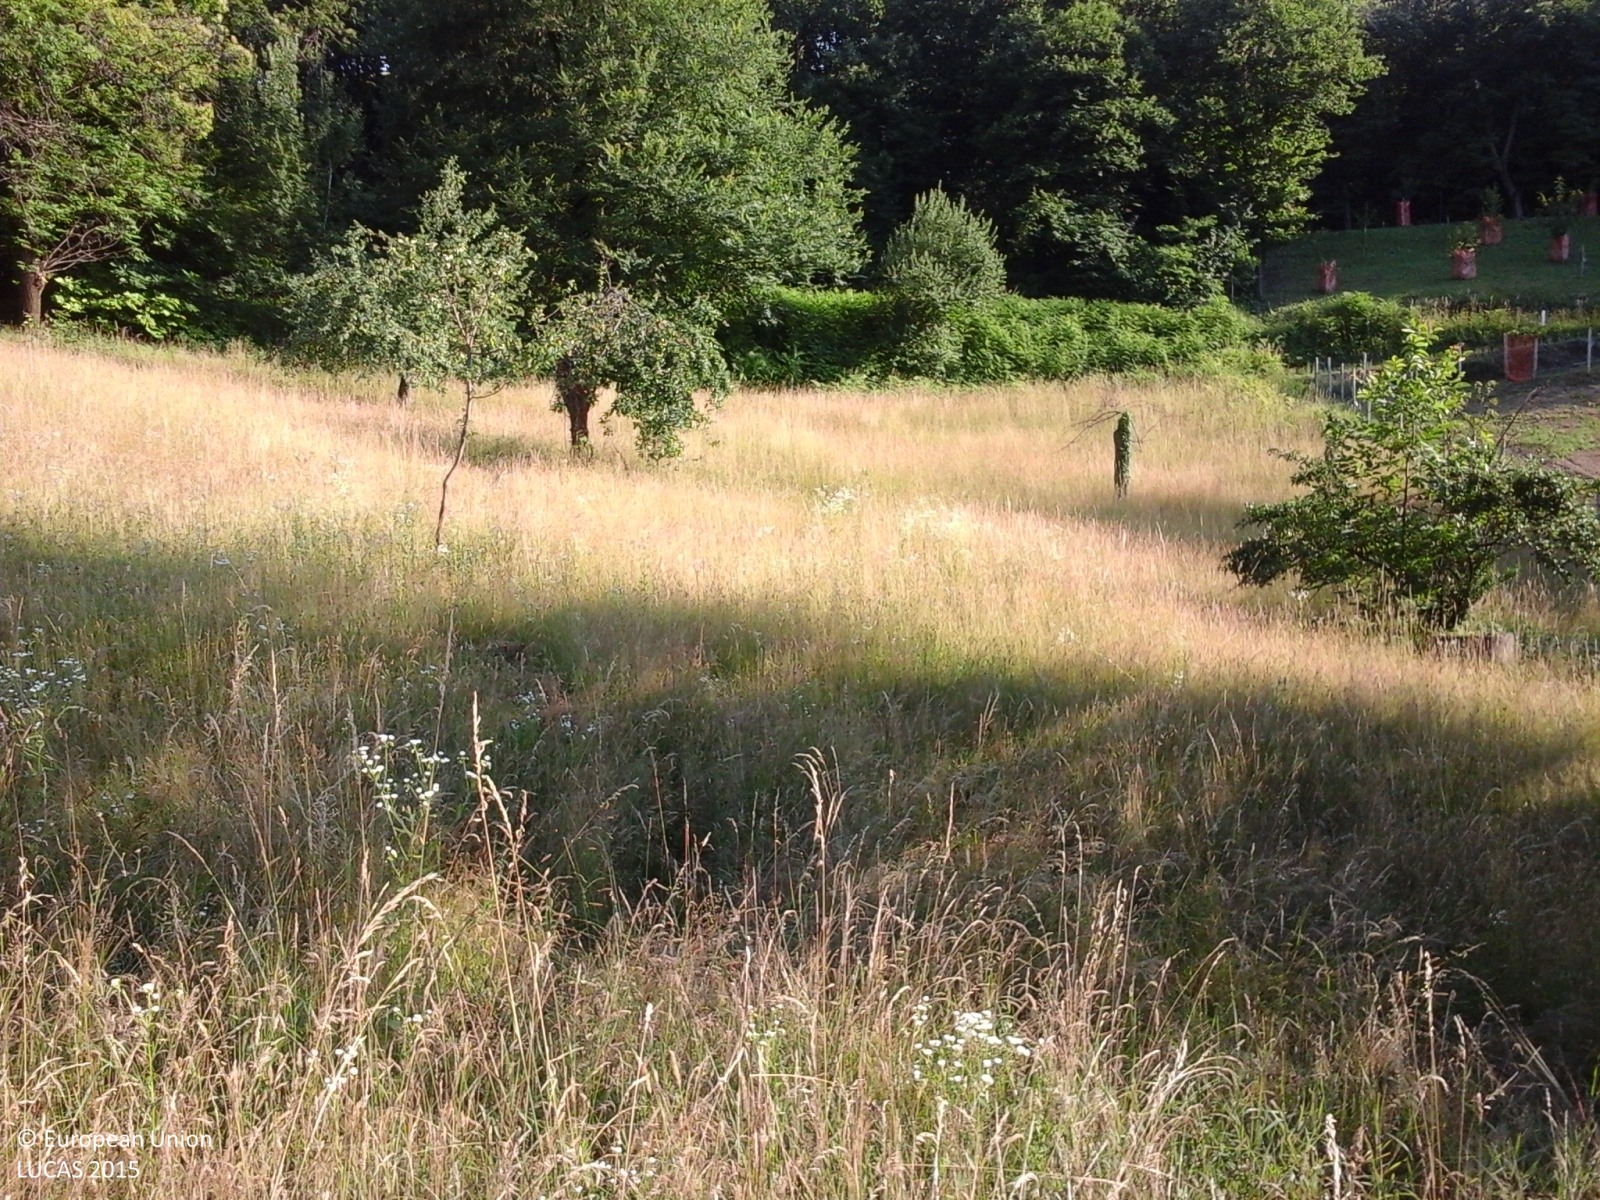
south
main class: Grassland
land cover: Grassland without tree/shrub cover
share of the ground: > 75 %
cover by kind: herbaceous plants 100 %
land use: Agriculture (excluding fallow land and kitchen gardens)
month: June
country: IT
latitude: 44.3460
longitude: 7.8346
